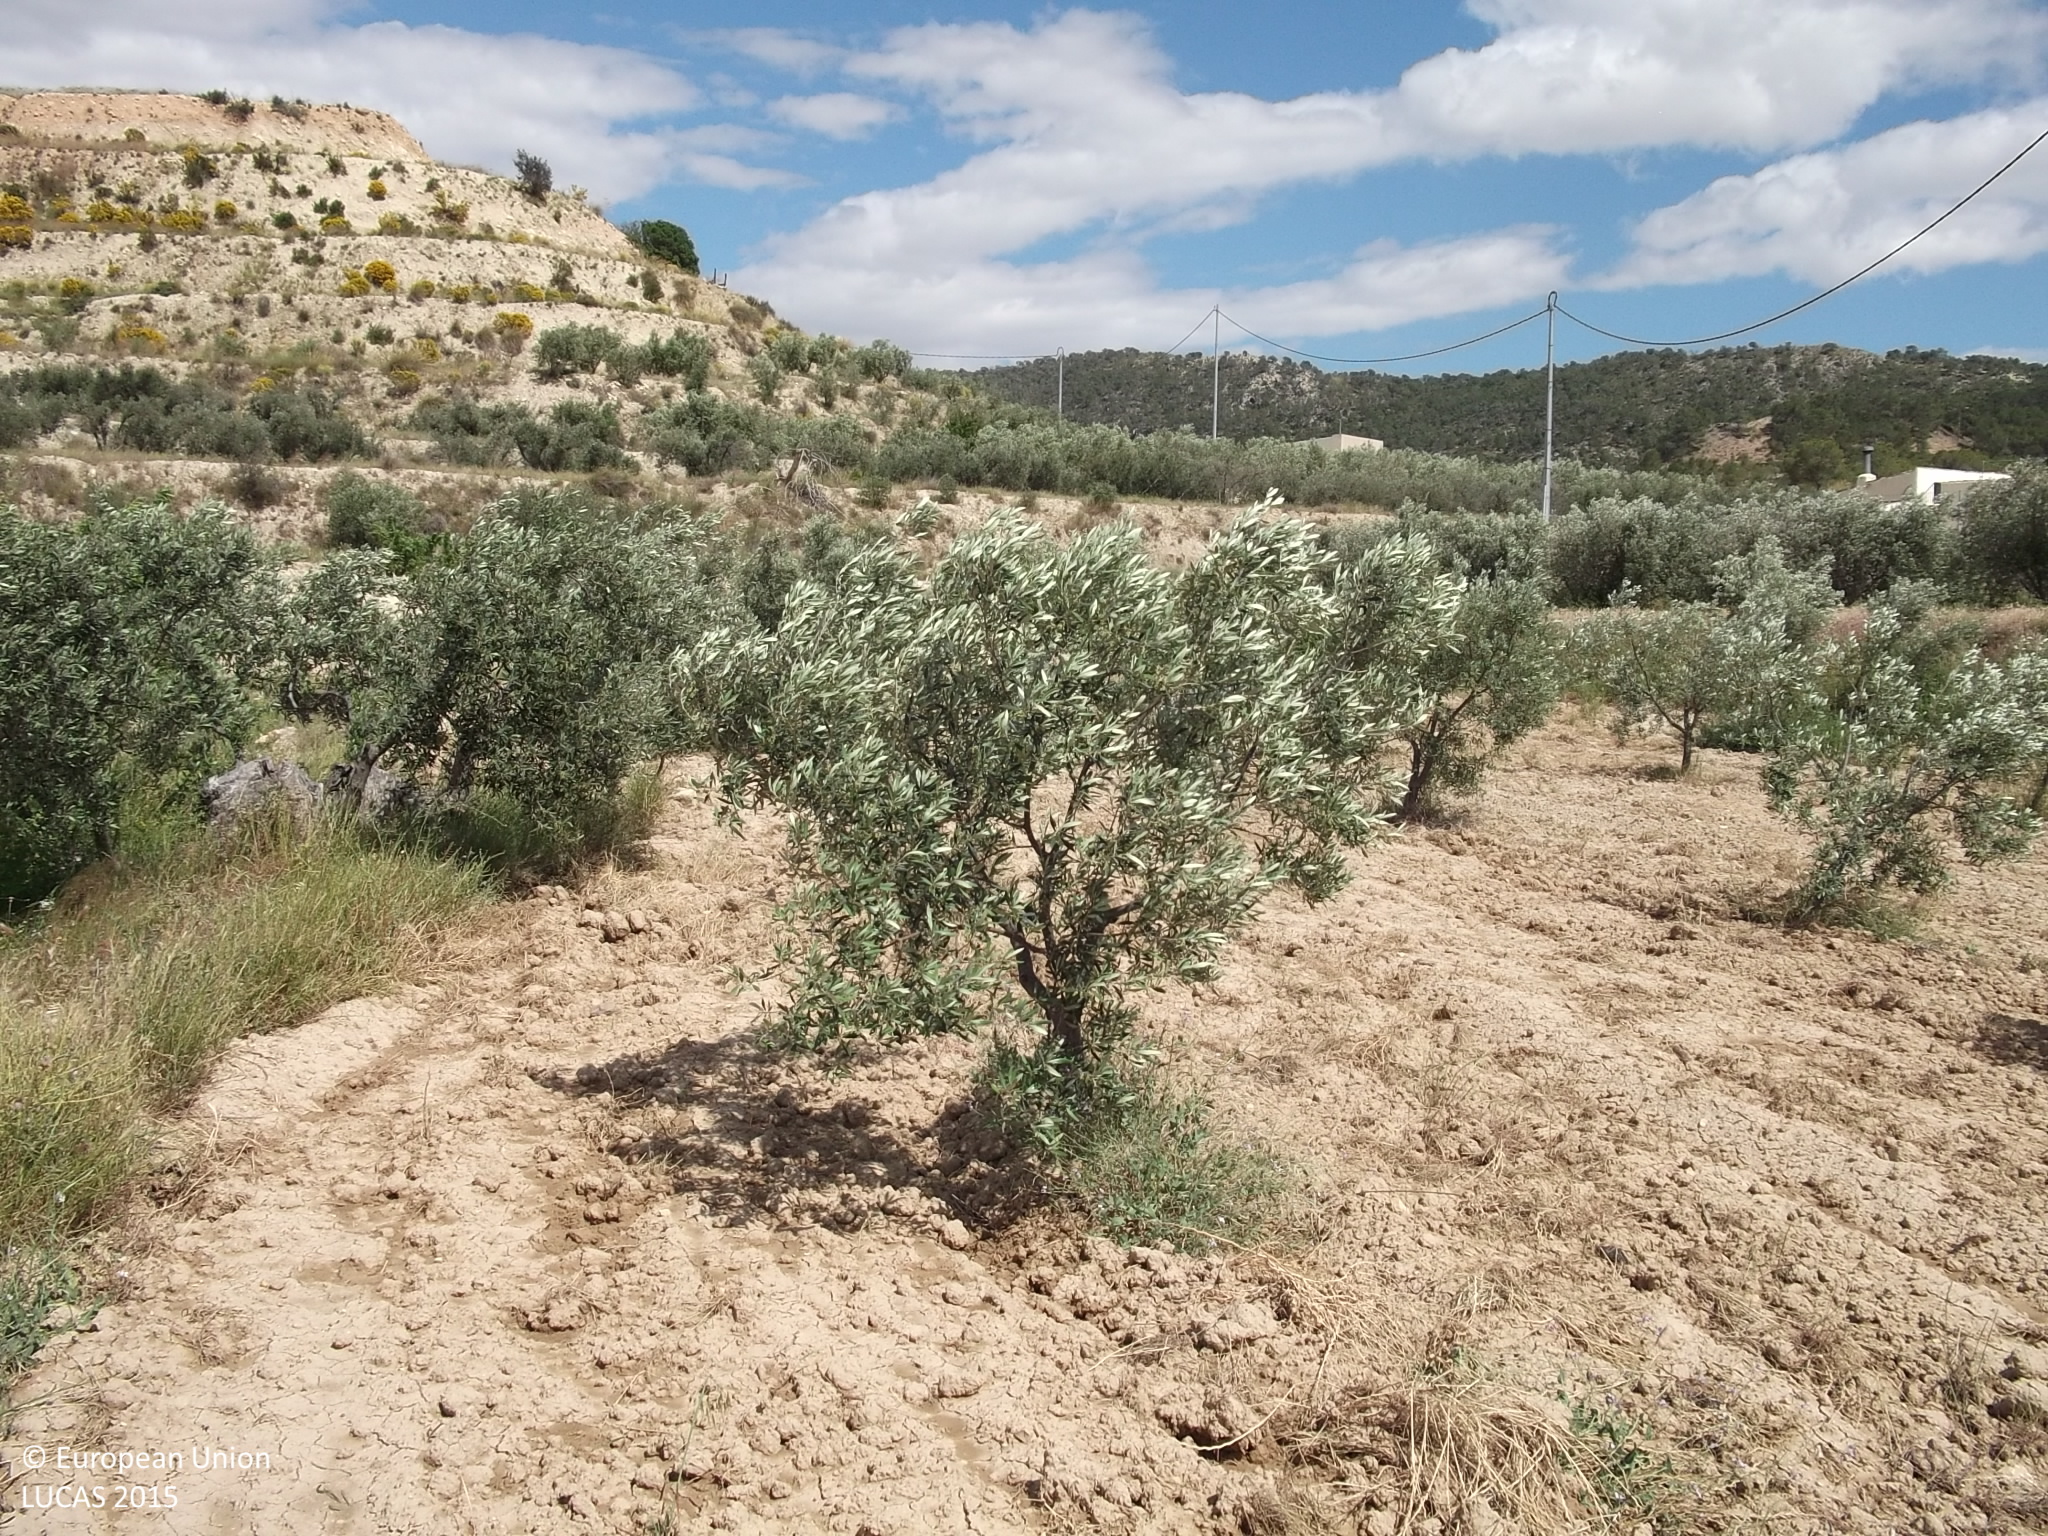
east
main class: Cropland
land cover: Olive groves
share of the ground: 10 - 25 %
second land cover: Other bare soil
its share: > 75 %
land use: Agriculture (excluding fallow land and kitchen gardens)
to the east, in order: Olive groves; Other bare soil; Tracks; Grass margins; Olive groves; Grass margins; Olive groves; Tracks; Spontaneously vegetated surfaces; Electric lines; Spontaneously vegetated surfaces; Grass margins; Spontaneously vegetated surfaces; Shrubland with sparse tree cover
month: April
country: ES
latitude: 38.1586
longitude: -1.3884
